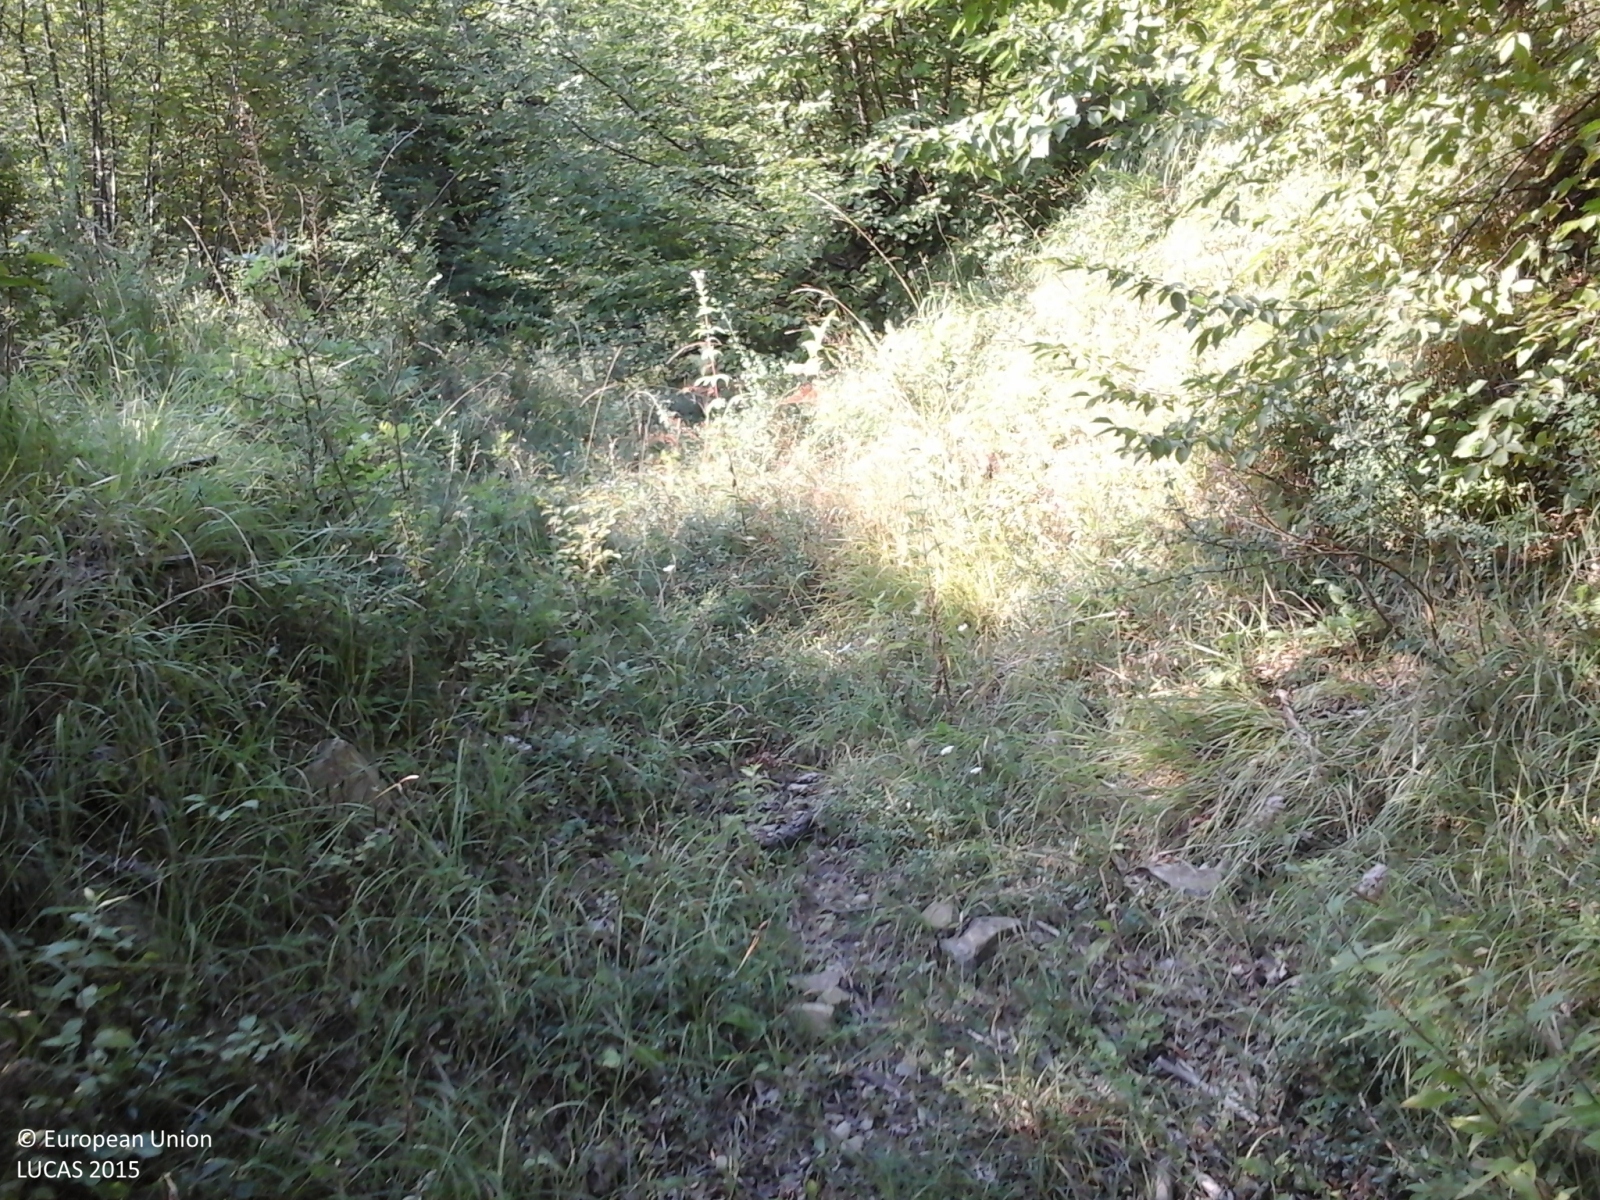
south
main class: Woodland
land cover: Broadleaved woodland
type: thermophilous deciduous forest
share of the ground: > 75 %
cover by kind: broadleaved forest trees 100 %
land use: Forestry
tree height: > 5 m
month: August
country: IT
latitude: 43.7494
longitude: 12.2174
